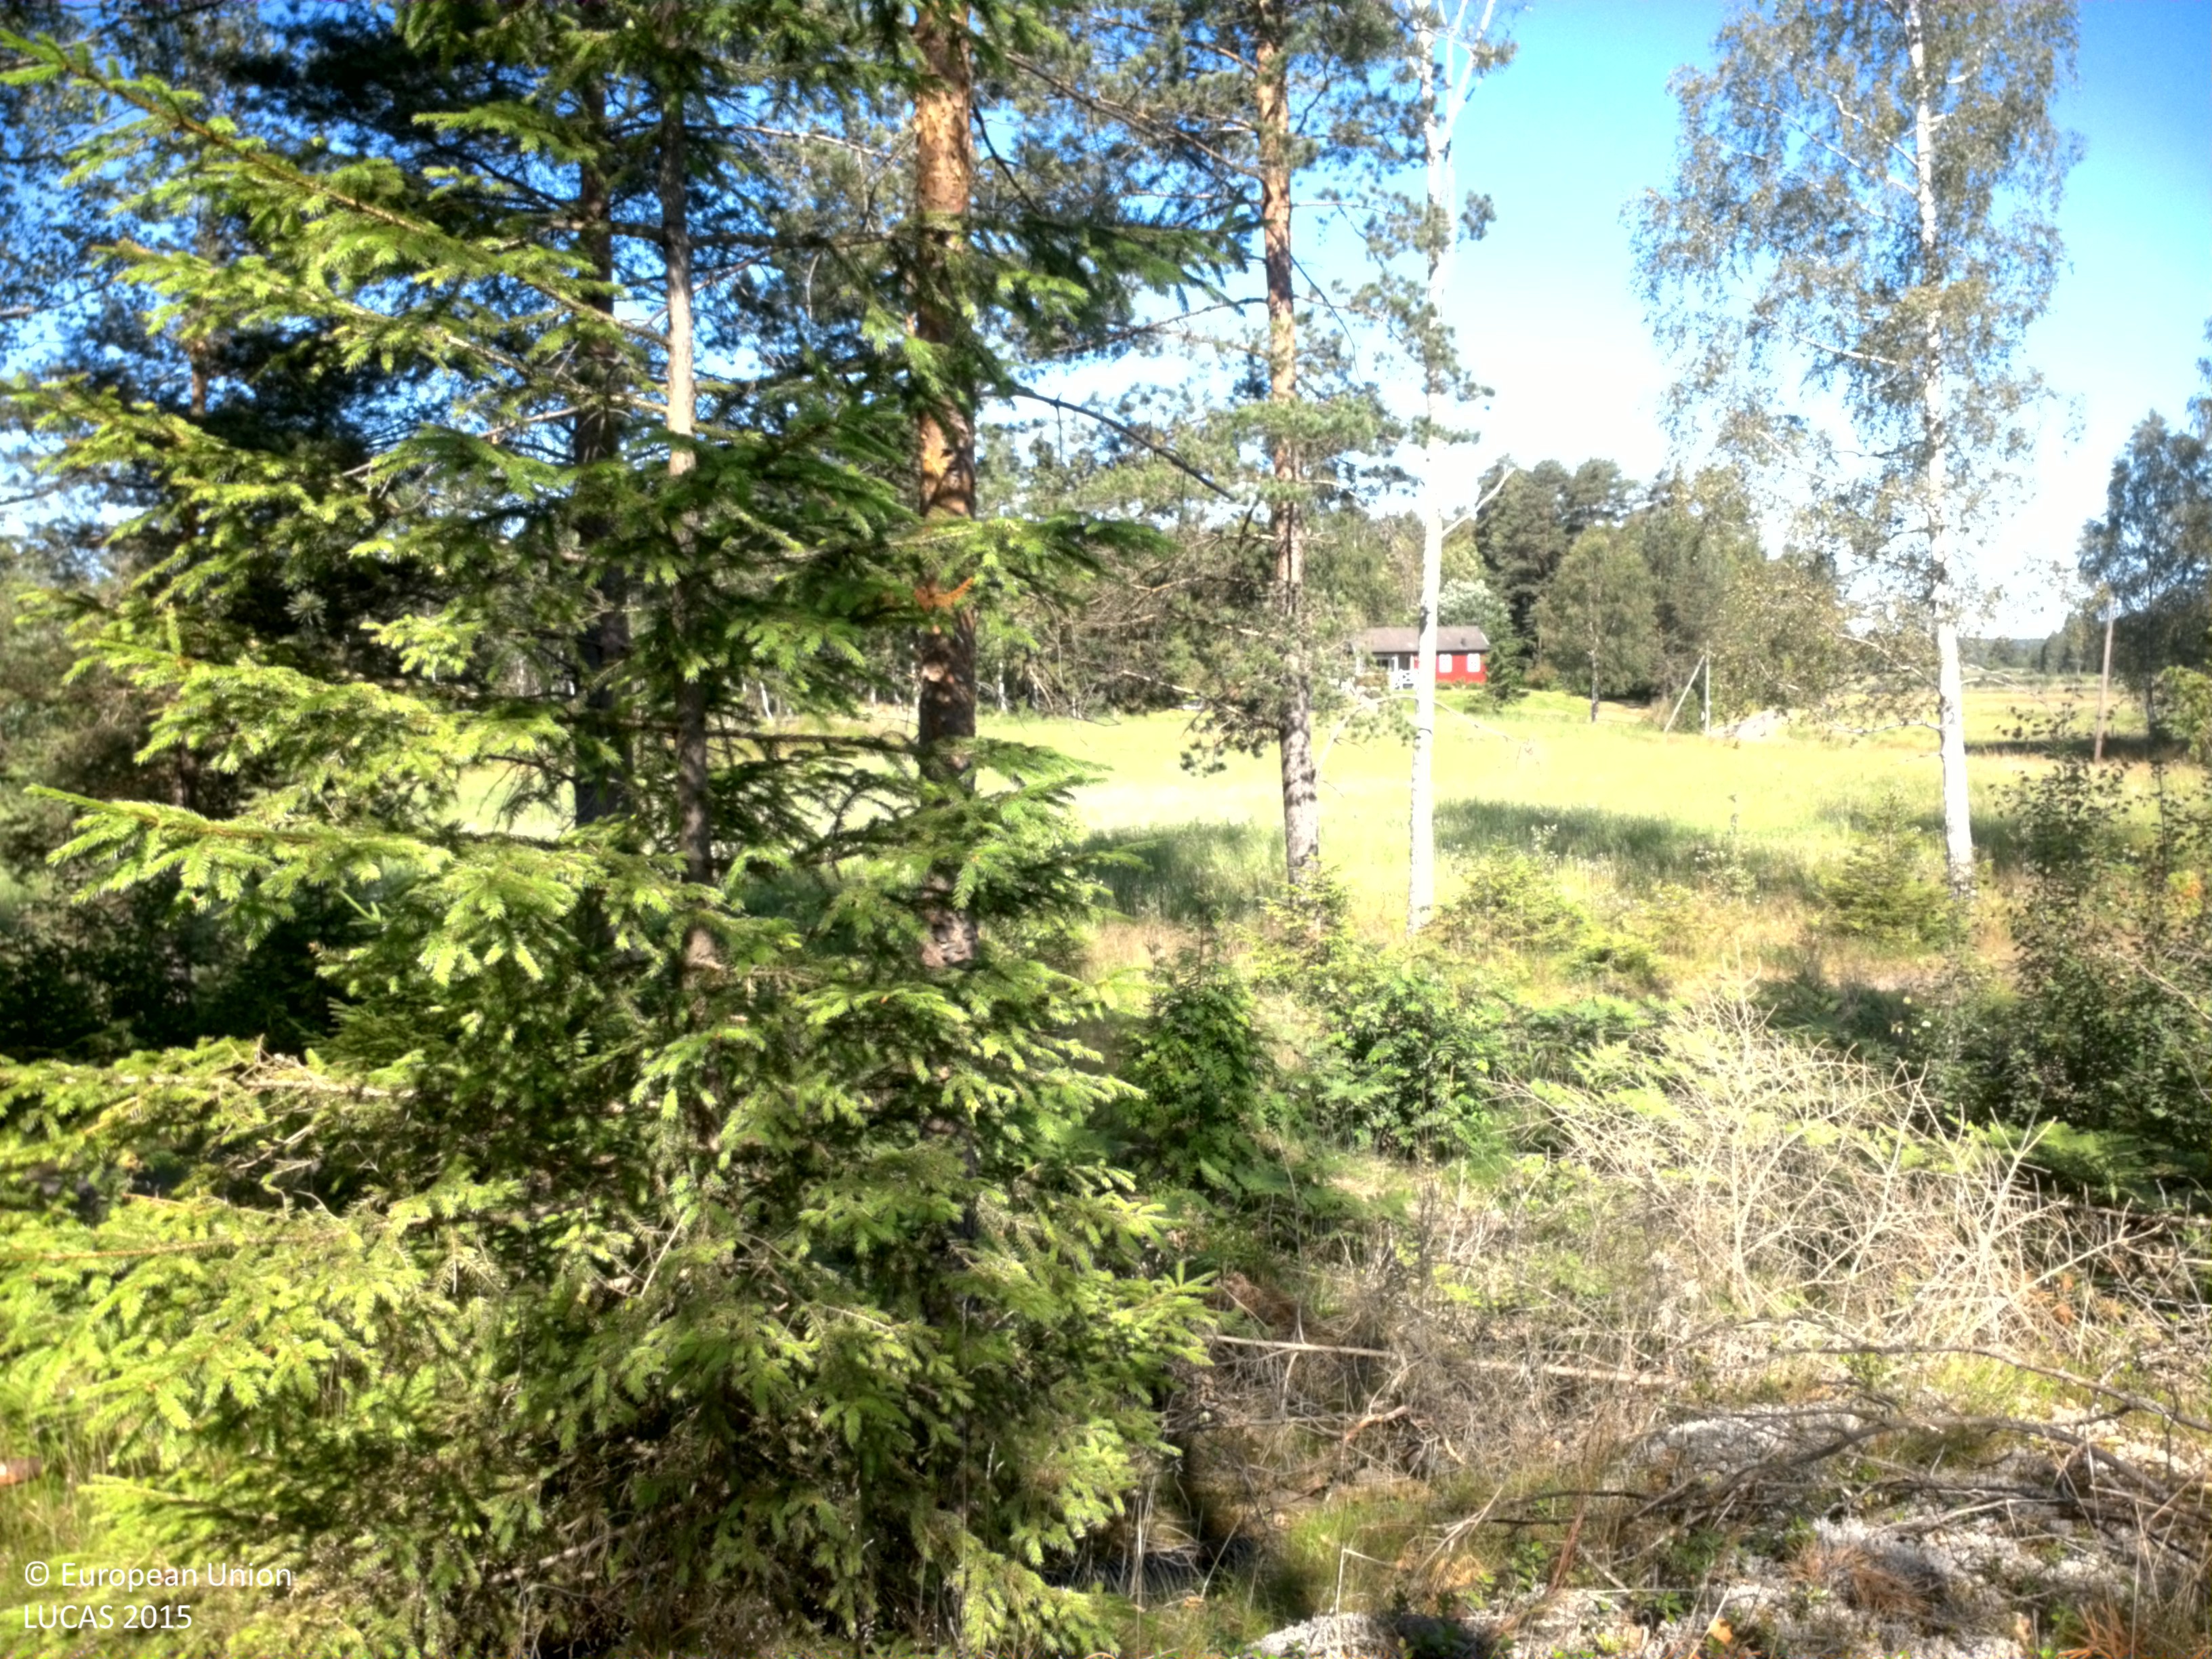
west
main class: Woodland
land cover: Pine dominated mixed woodland
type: boreal forest
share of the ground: 25 - 50 %
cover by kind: coniferous forest trees 35 %, lichens and mosses 25 %, shrubs 20 %, broadleaved forest trees 15 %, herbaceous plants 5 %
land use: Forestry
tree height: > 5 m
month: July
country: SE
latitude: 59.2812
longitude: 13.1344
